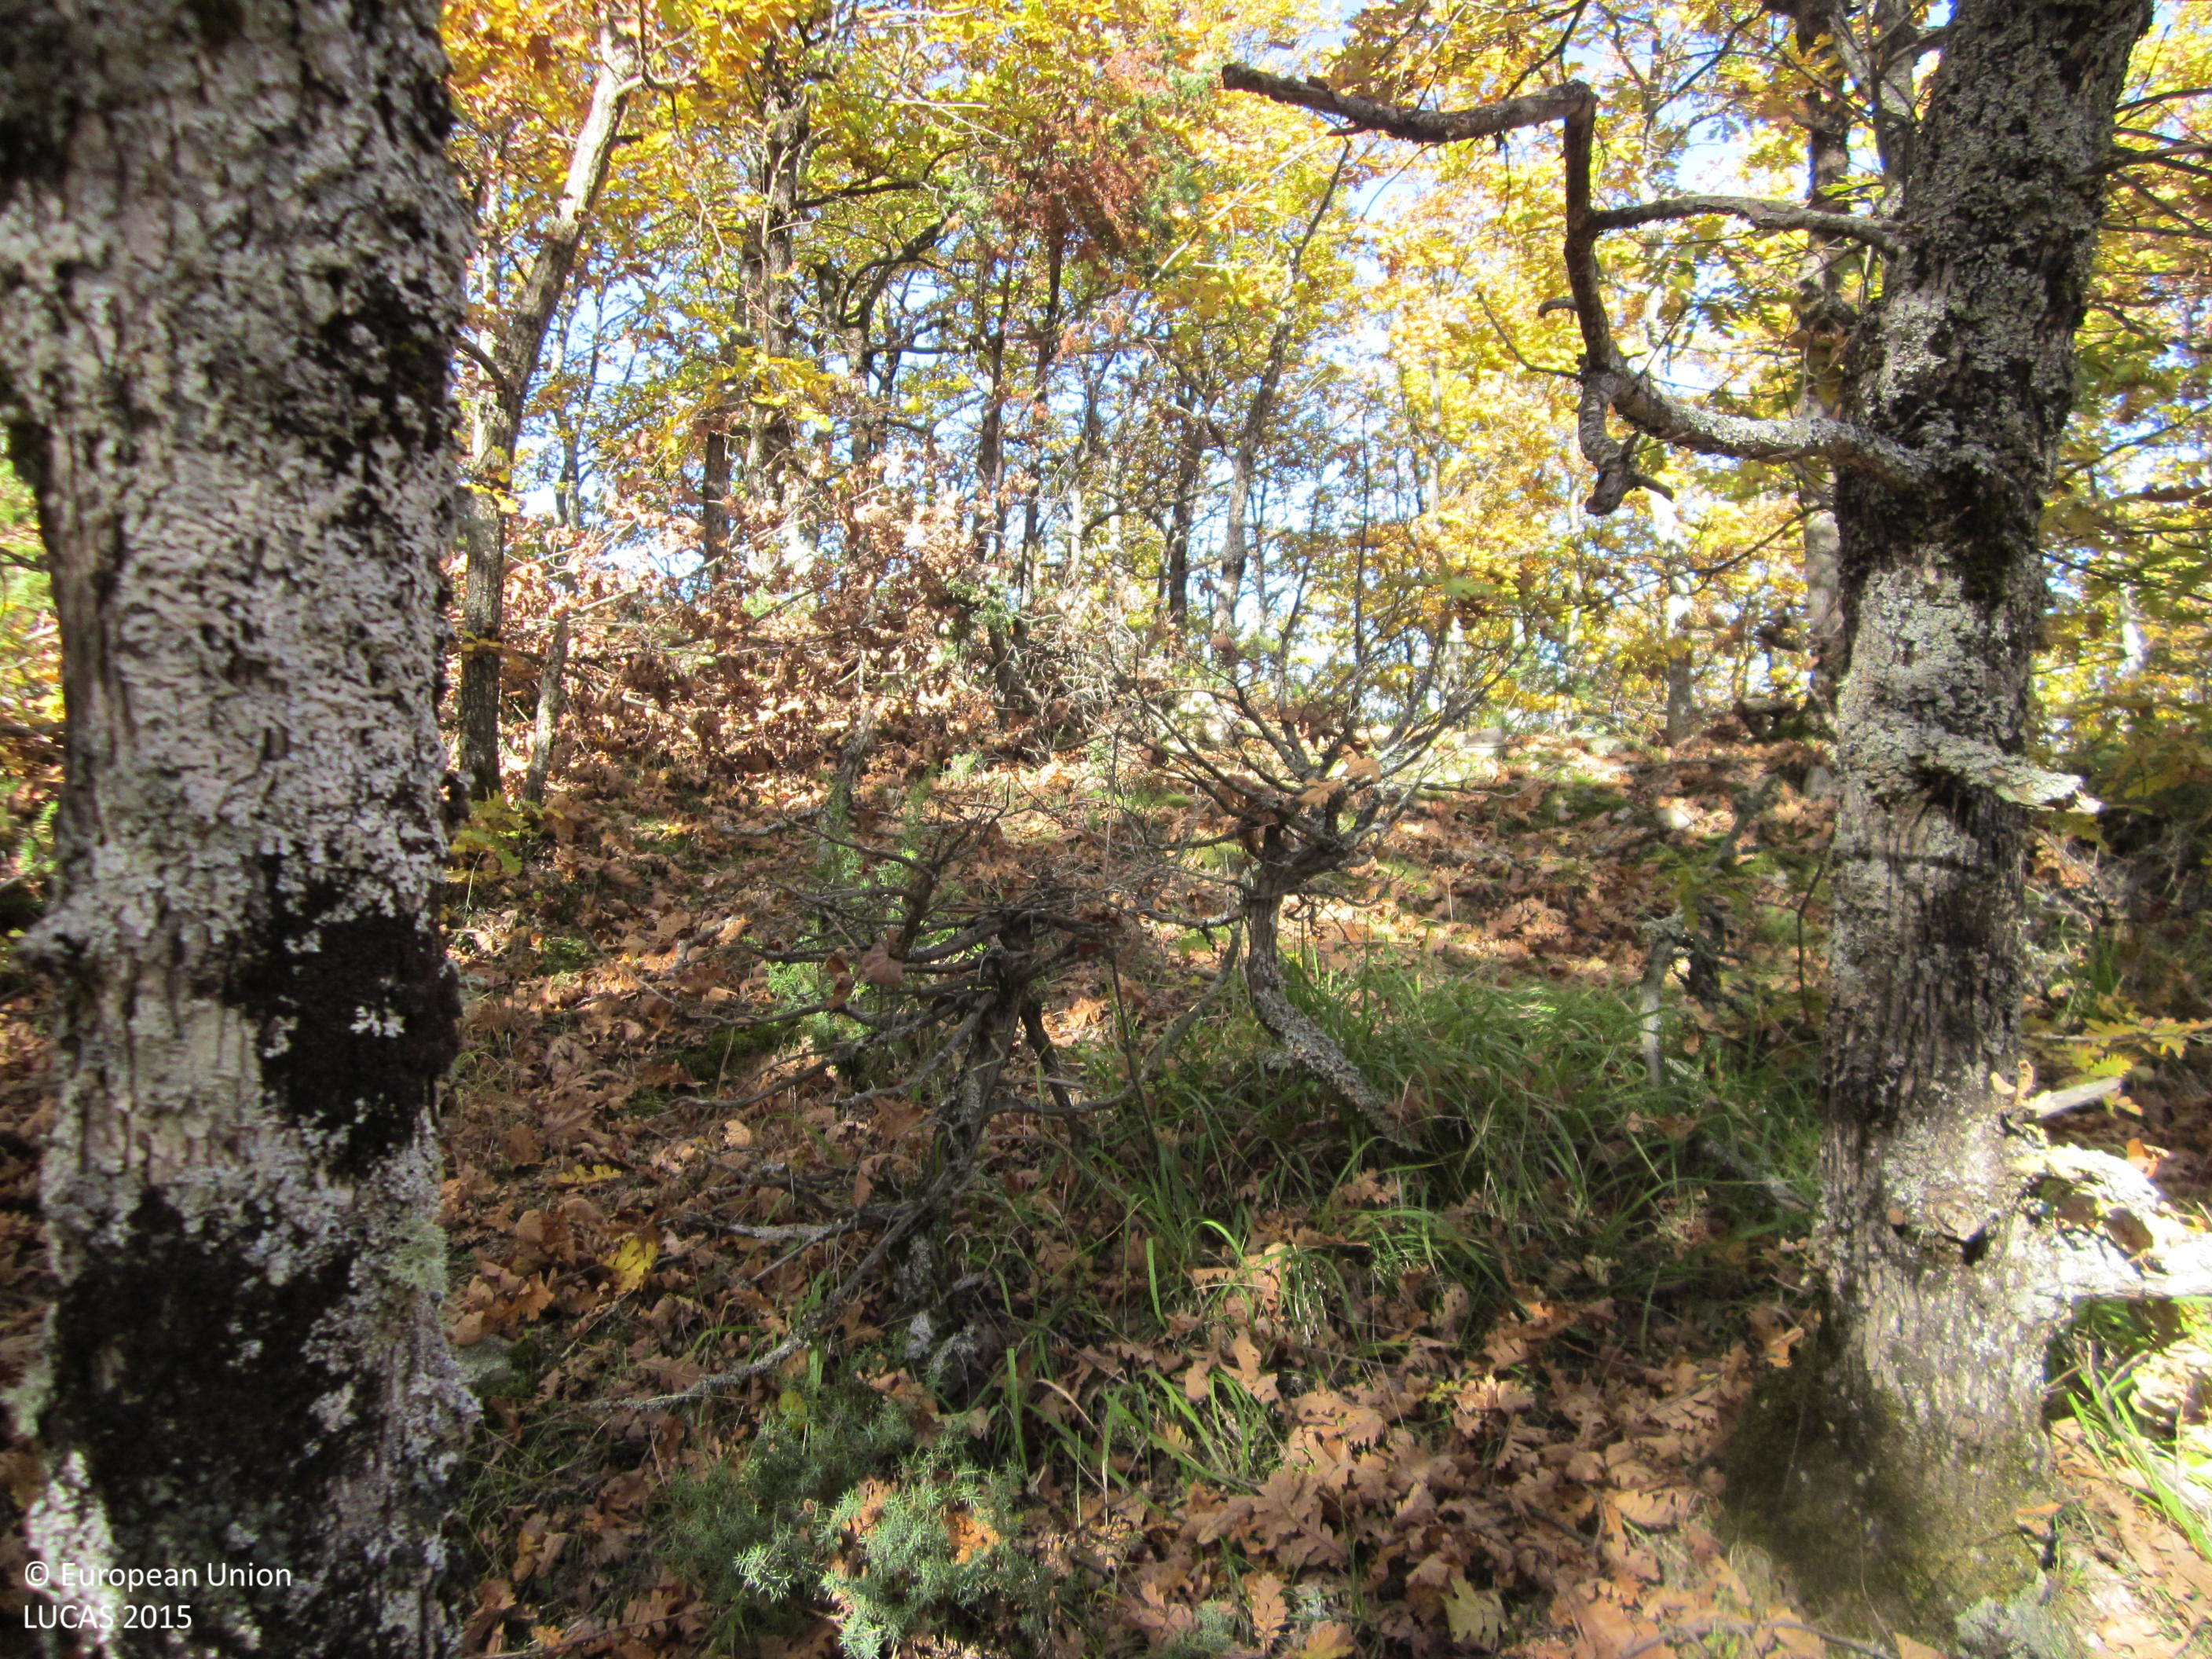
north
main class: Woodland
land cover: Broadleaved woodland
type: mesophytic deciduous forest
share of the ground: > 75 %
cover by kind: broadleaved forest trees 80 %, shrubs 5 %, herbaceous plants 5 %, lichens and mosses 5 %, unconsolidated bare surface 5 %
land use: Forestry
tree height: > 5 m
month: November
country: BG
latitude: 41.3365
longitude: 25.6524
